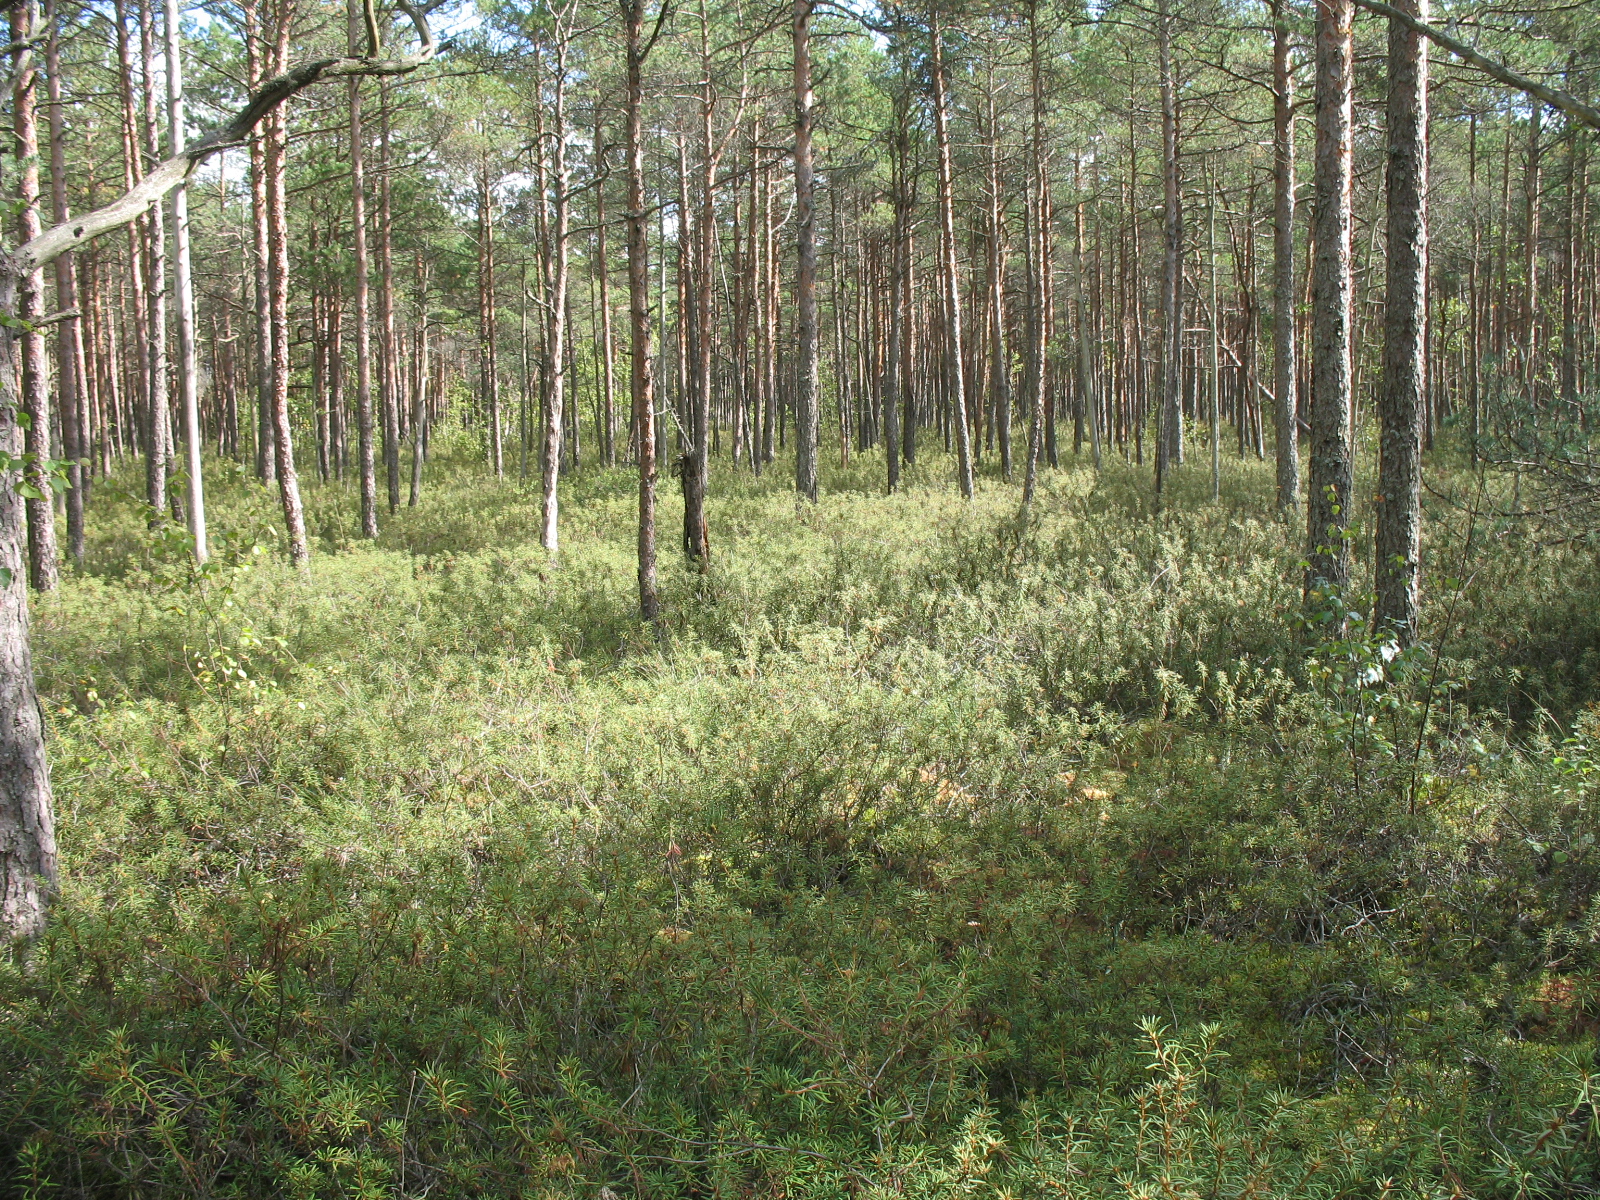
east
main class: Woodland
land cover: Pine dominated coniferous woodland
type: hemiboreal forest and nemoral coniferous forest and mixed broadleaved-coniferous forest
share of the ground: 25 - 50 %
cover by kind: coniferous forest trees 40 %, lichens and mosses 30 %, herbaceous plants 15 %, shrubs 10 %, broadleaved forest trees 5 %
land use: Forestry
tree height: > 5 m
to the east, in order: Pine dominated coniferous woodland; Broadleaved woodland; Shruby margins; Triticale
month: September
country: LV
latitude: 56.1631
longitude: 25.4337
